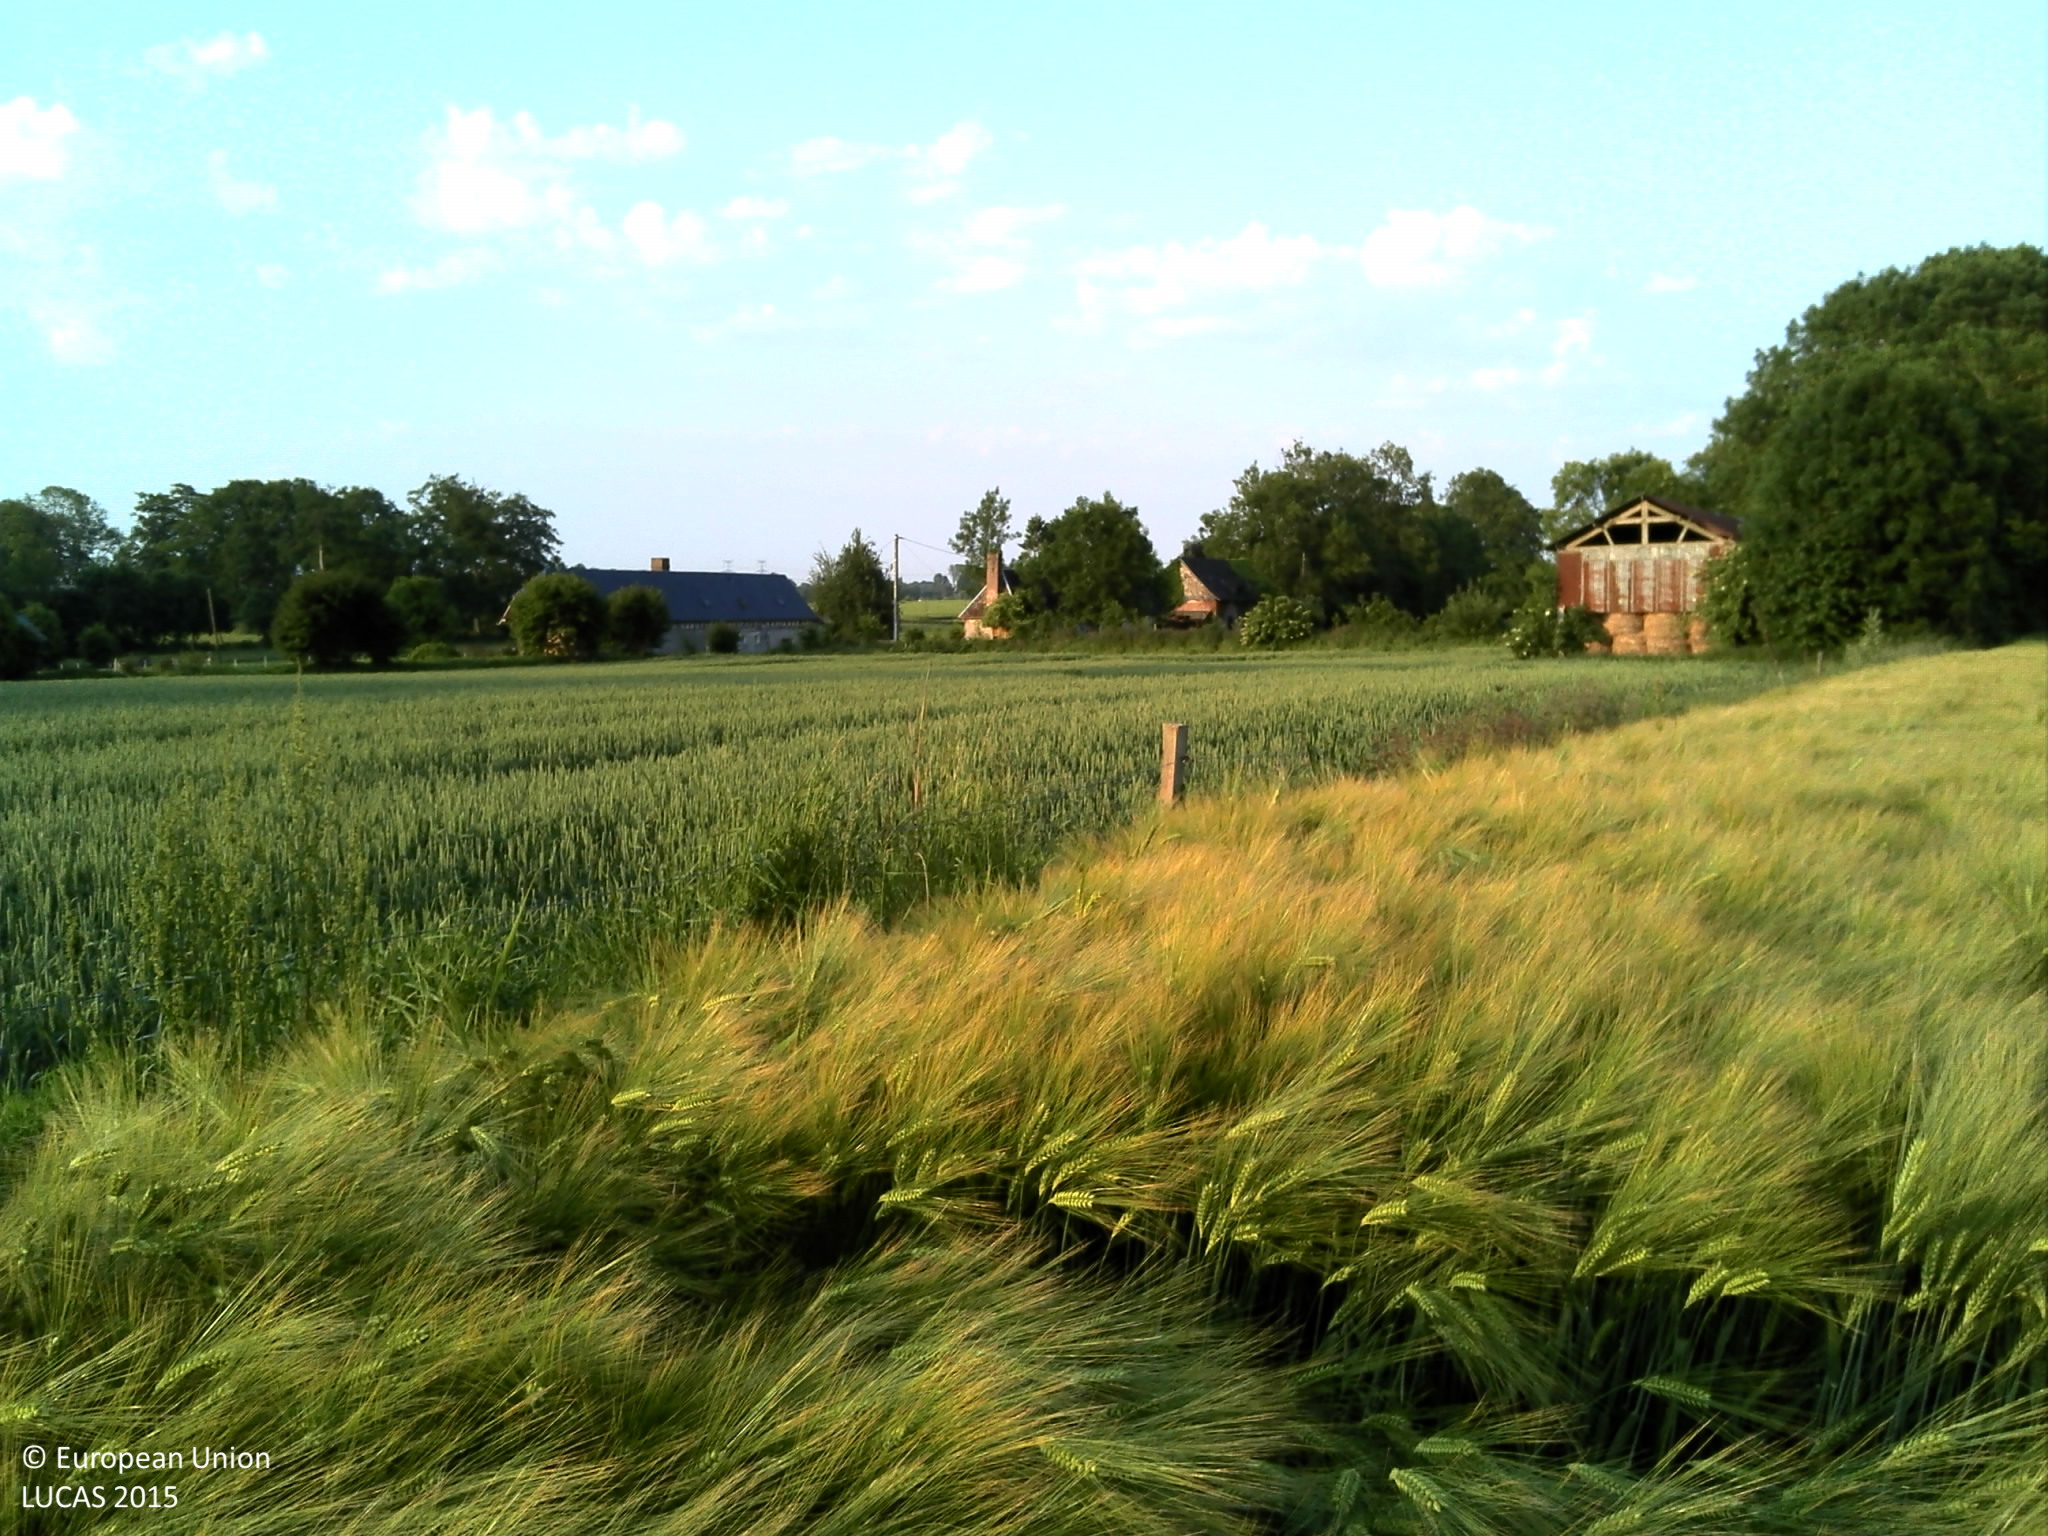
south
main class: Cropland
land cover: Barley
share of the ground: > 75 %
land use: Agriculture (excluding fallow land and kitchen gardens)
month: June
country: FR
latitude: 49.6703
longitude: 1.0685
